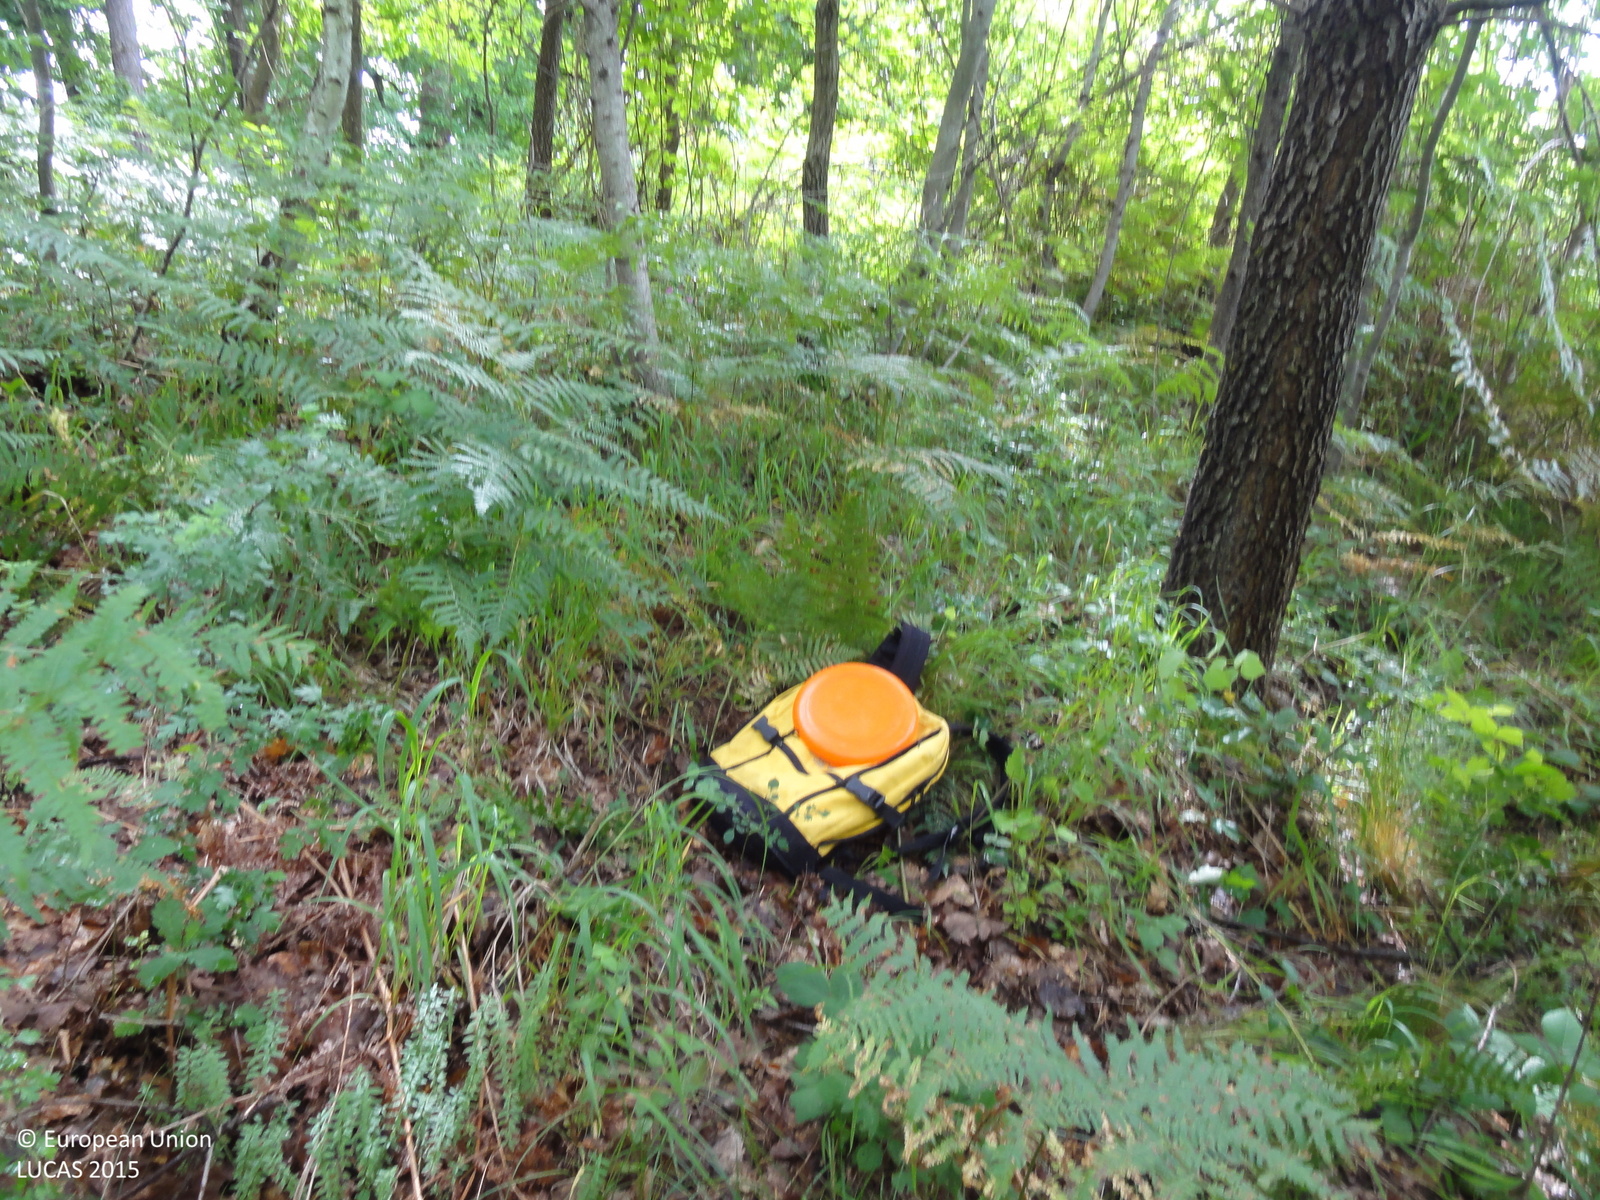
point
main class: Woodland
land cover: Broadleaved woodland
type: mesophytic deciduous forest
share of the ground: > 75 %
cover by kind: broadleaved forest trees 85 %, herbaceous plants 10 %, shrubs 5 %
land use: Forestry
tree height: > 5 m
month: June
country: SI
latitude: 46.3034
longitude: 15.7764
